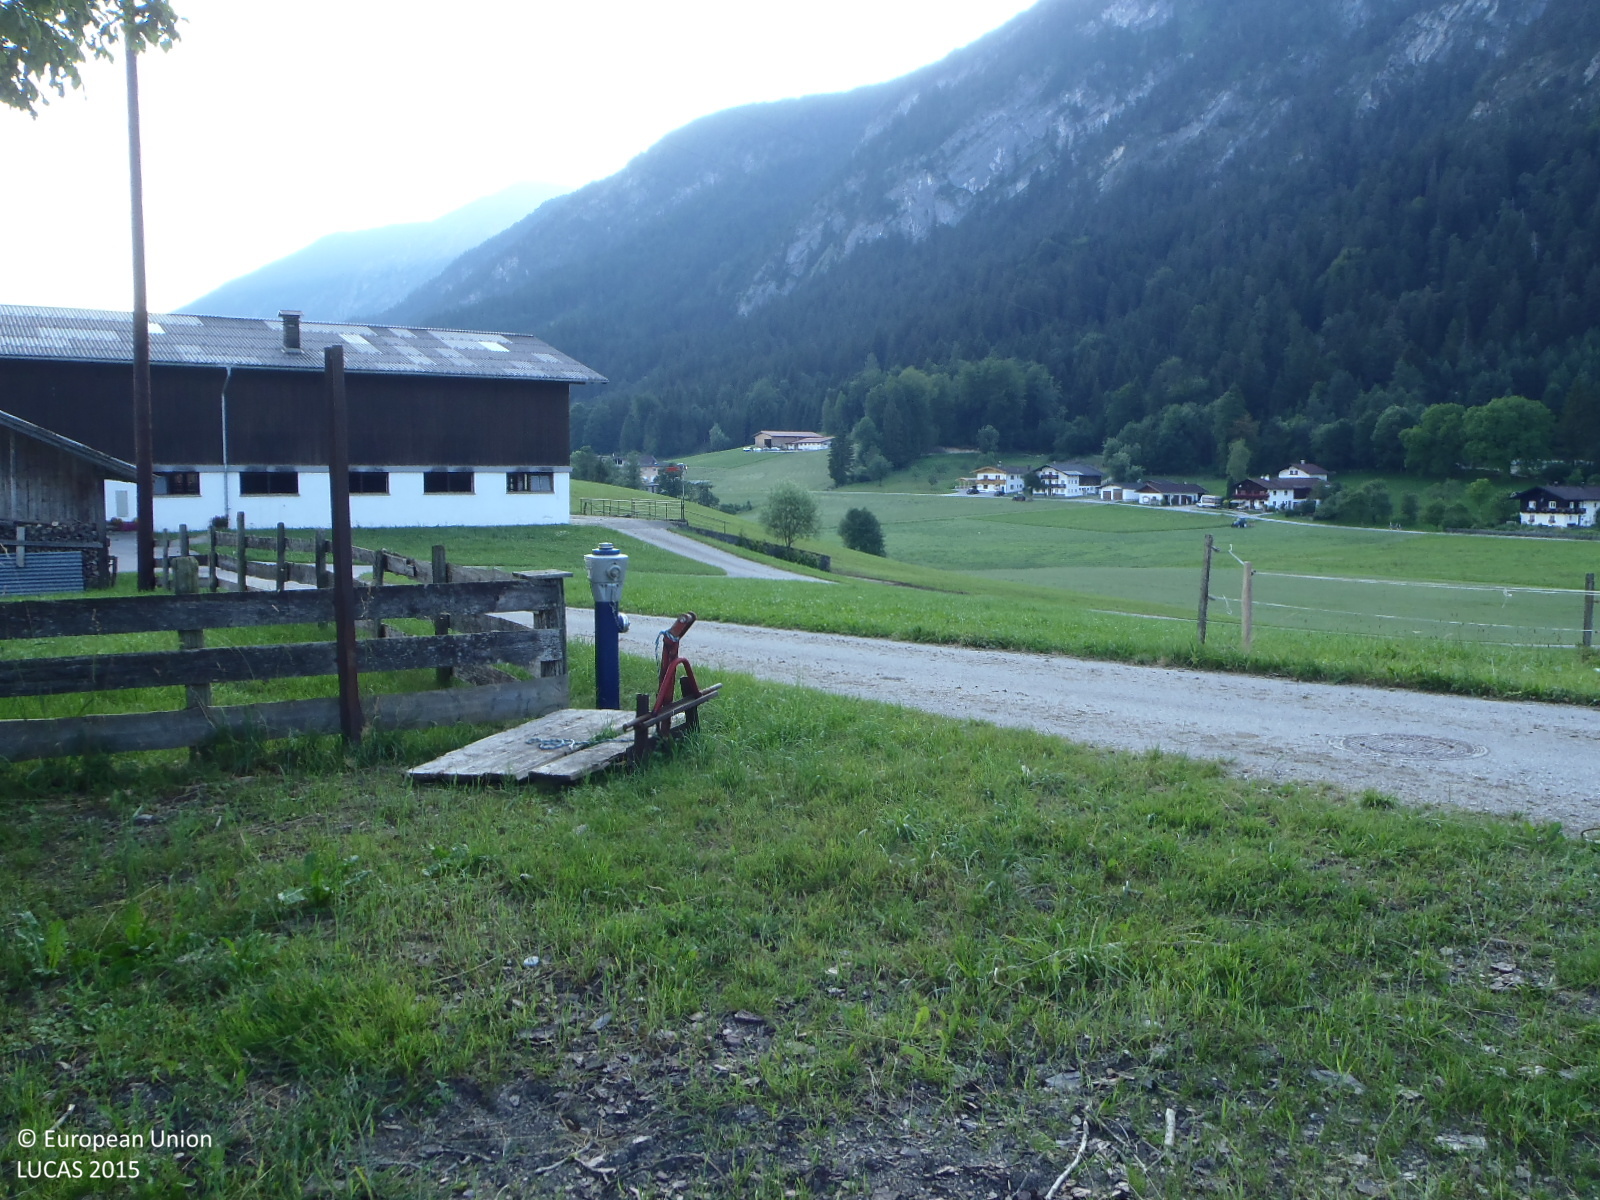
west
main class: Grassland
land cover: Grassland without tree/shrub cover
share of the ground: 50 - 75 %
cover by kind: herbaceous plants 60 %, unconsolidated bare surface 40 %
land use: Agriculture (excluding fallow land and kitchen gardens)
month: July
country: AT
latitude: 47.5207
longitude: 12.0304
